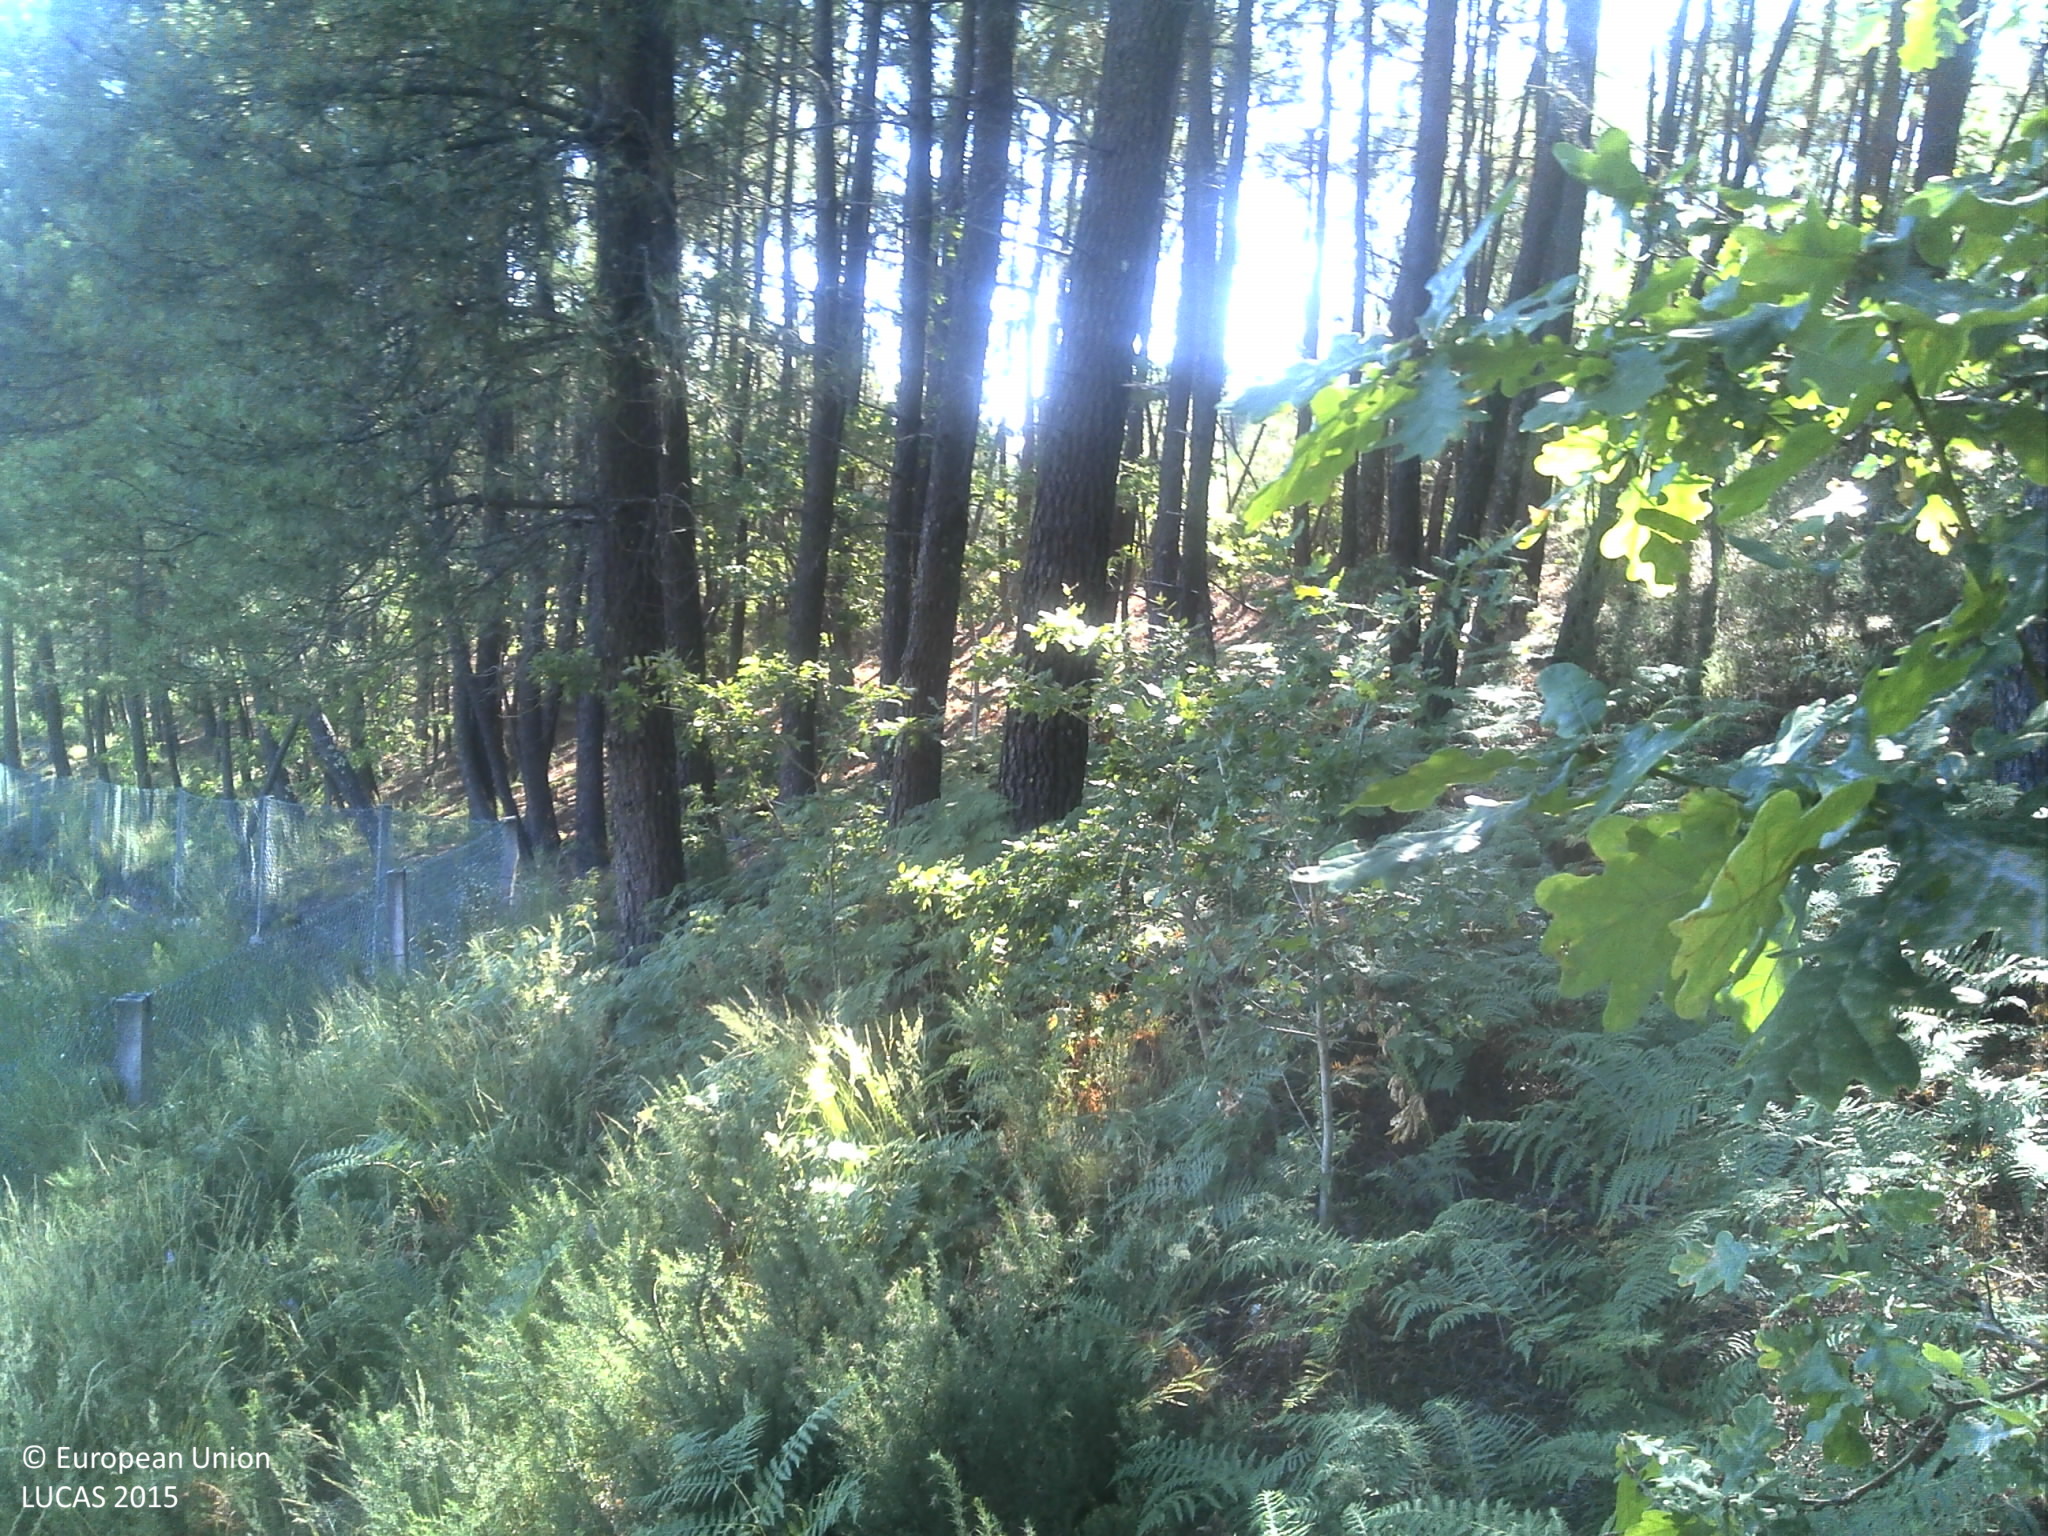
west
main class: Woodland
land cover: Pine dominated coniferous woodland
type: coniferous forest of the mediterranean region
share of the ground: 50 - 75 %
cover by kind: coniferous forest trees 70 %, shrubs 15 %, unconsolidated bare surface 10 %, herbaceous plants 5 %
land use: Forestry
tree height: > 5 m
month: June
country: PT
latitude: 41.3698
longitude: -8.1356
